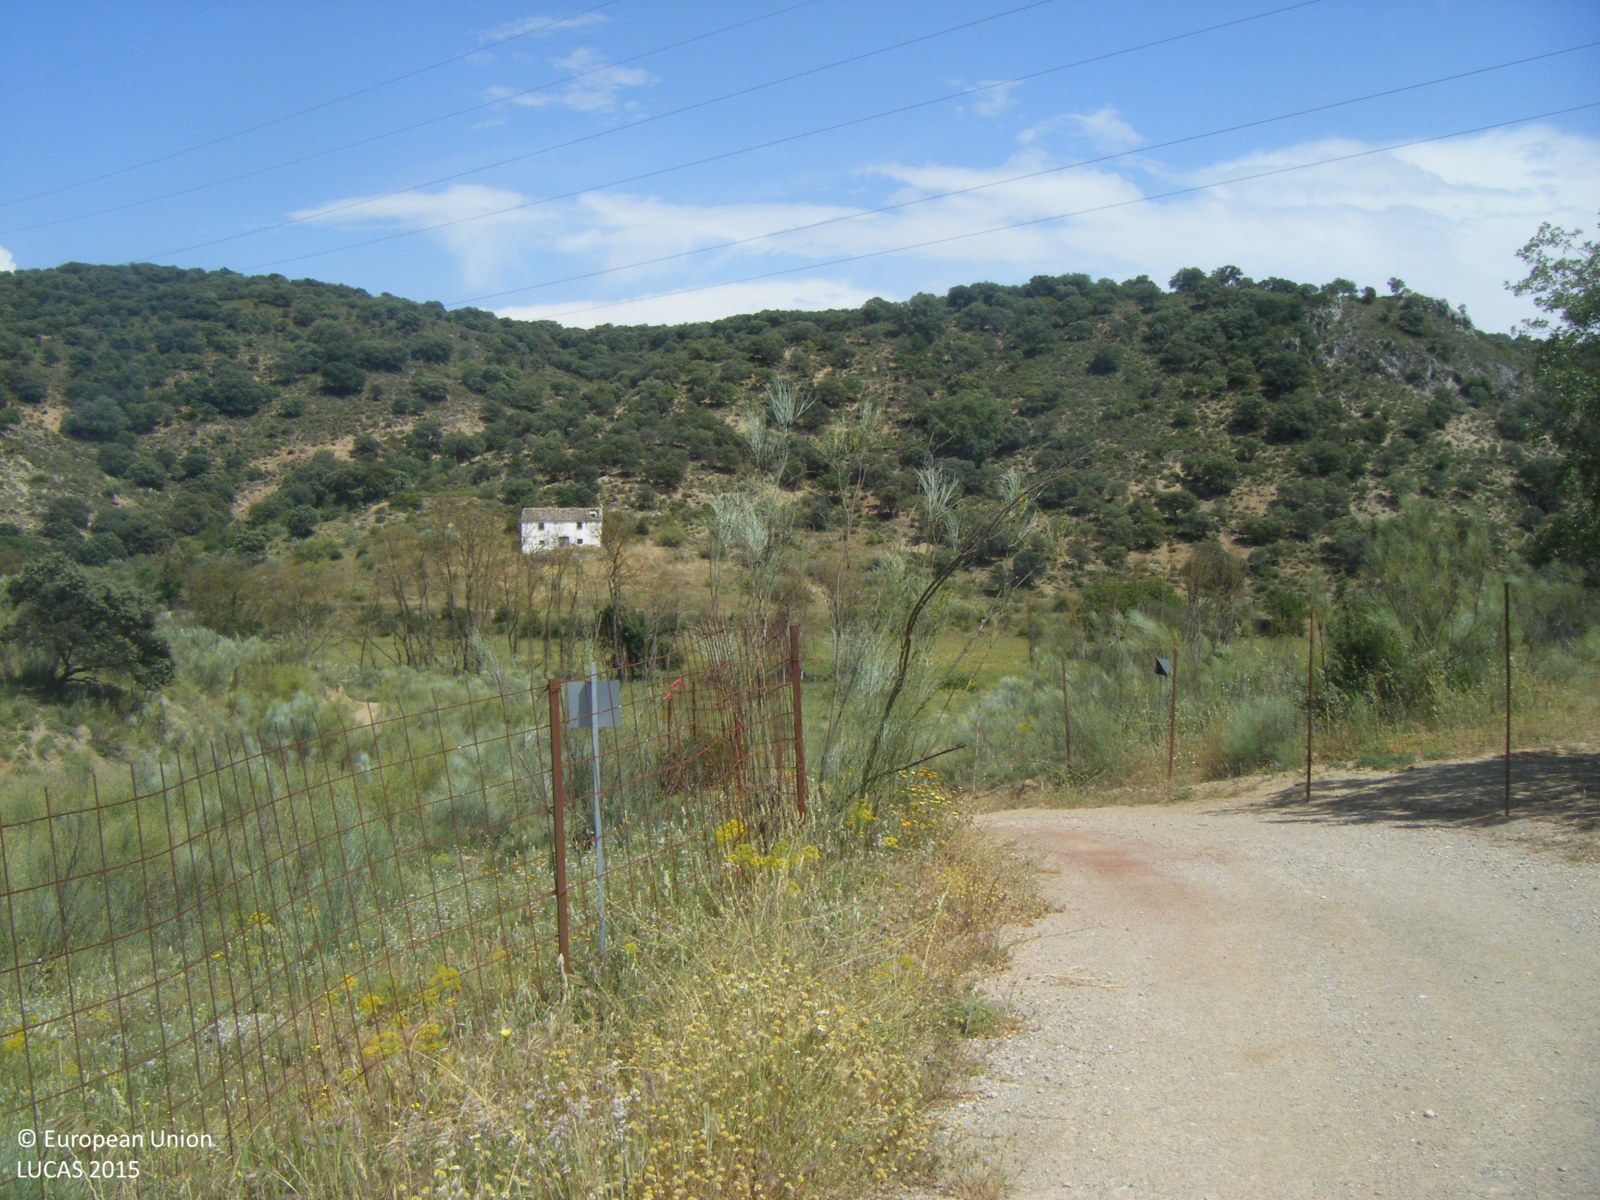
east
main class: Cropland
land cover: Olive groves
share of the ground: 10 - 25 %
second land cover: Other bare soil
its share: > 75 %
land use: Agriculture (excluding fallow land and kitchen gardens)
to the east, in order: Olive groves; Other bare soil; Fences; Olive groves; Groves; Rivers and streams; Groves; Arable land (only in case pi); Shrubland without tree cover; Tracks; Broadleaved woodland
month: May
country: ES
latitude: 37.0924
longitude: -4.3628
